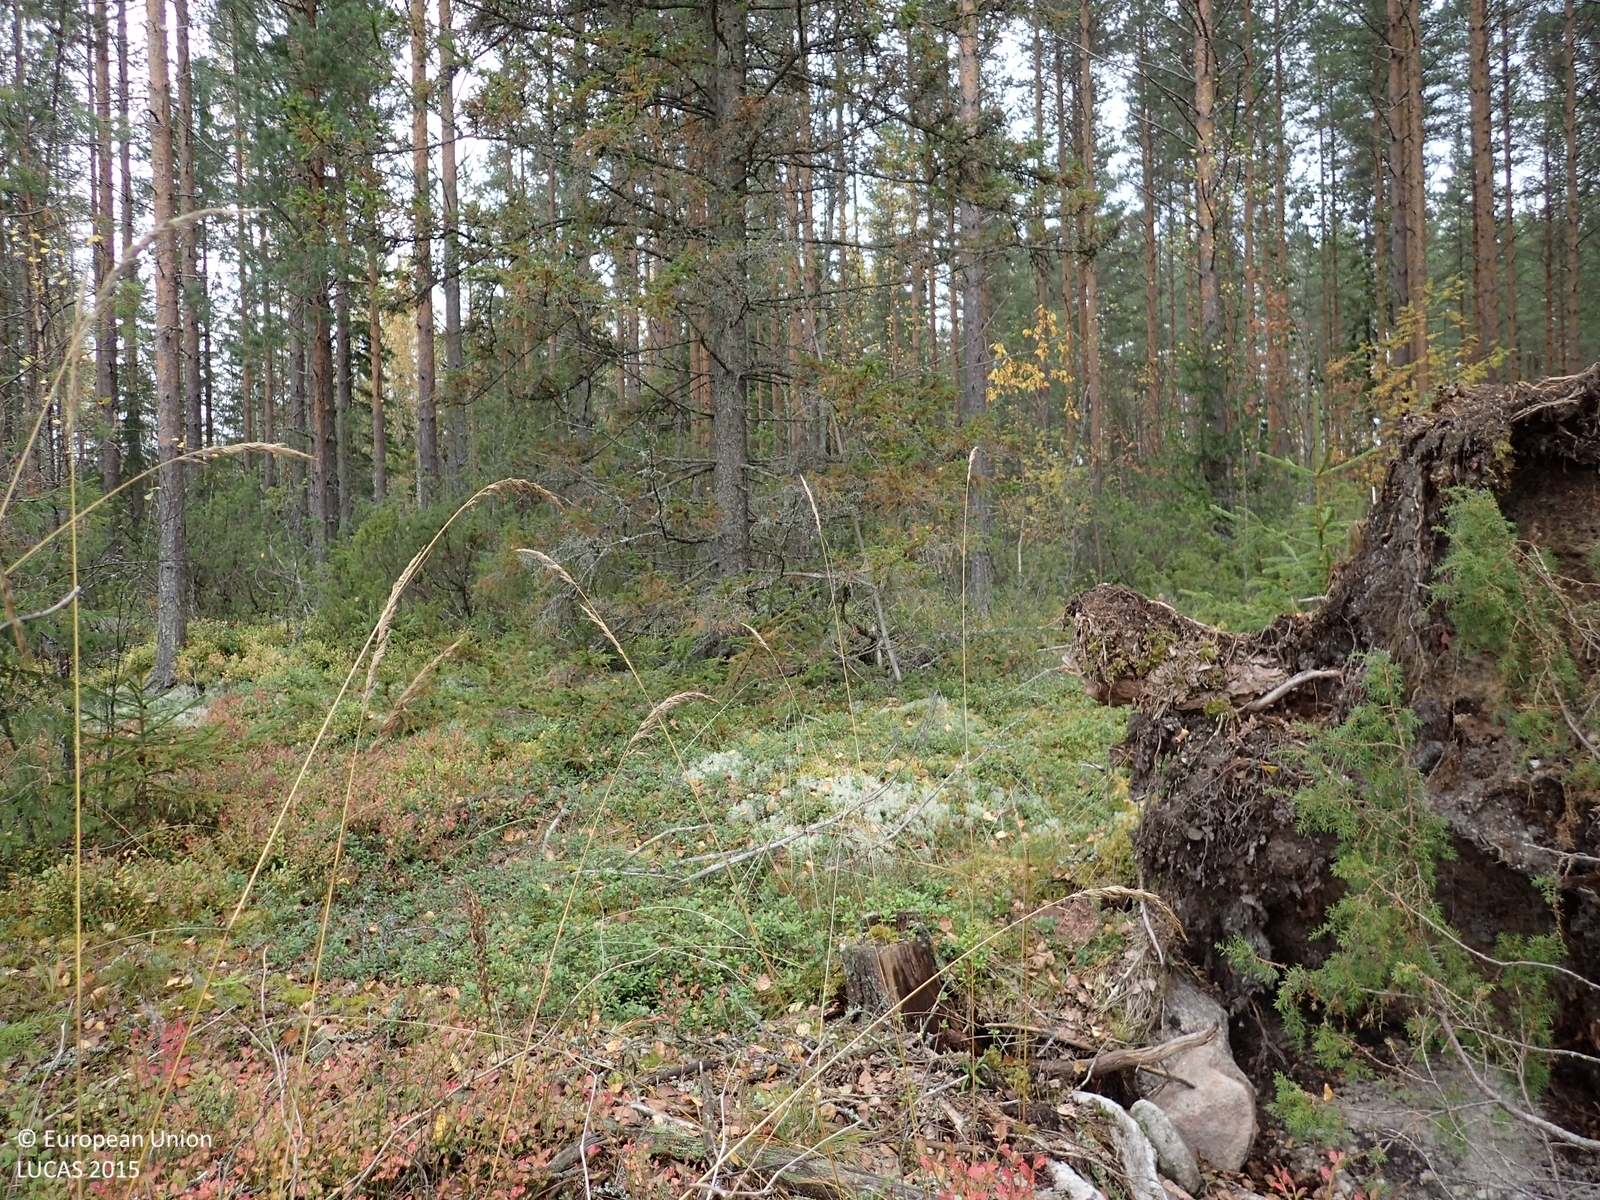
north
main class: Woodland
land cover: Pine dominated mixed woodland
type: boreal forest
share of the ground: > 75 %
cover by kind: coniferous forest trees 60 %, broadleaved forest trees 20 %, shrubs 20 %
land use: Forestry
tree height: > 5 m
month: September
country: FI
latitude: 62.9187
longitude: 26.4540
